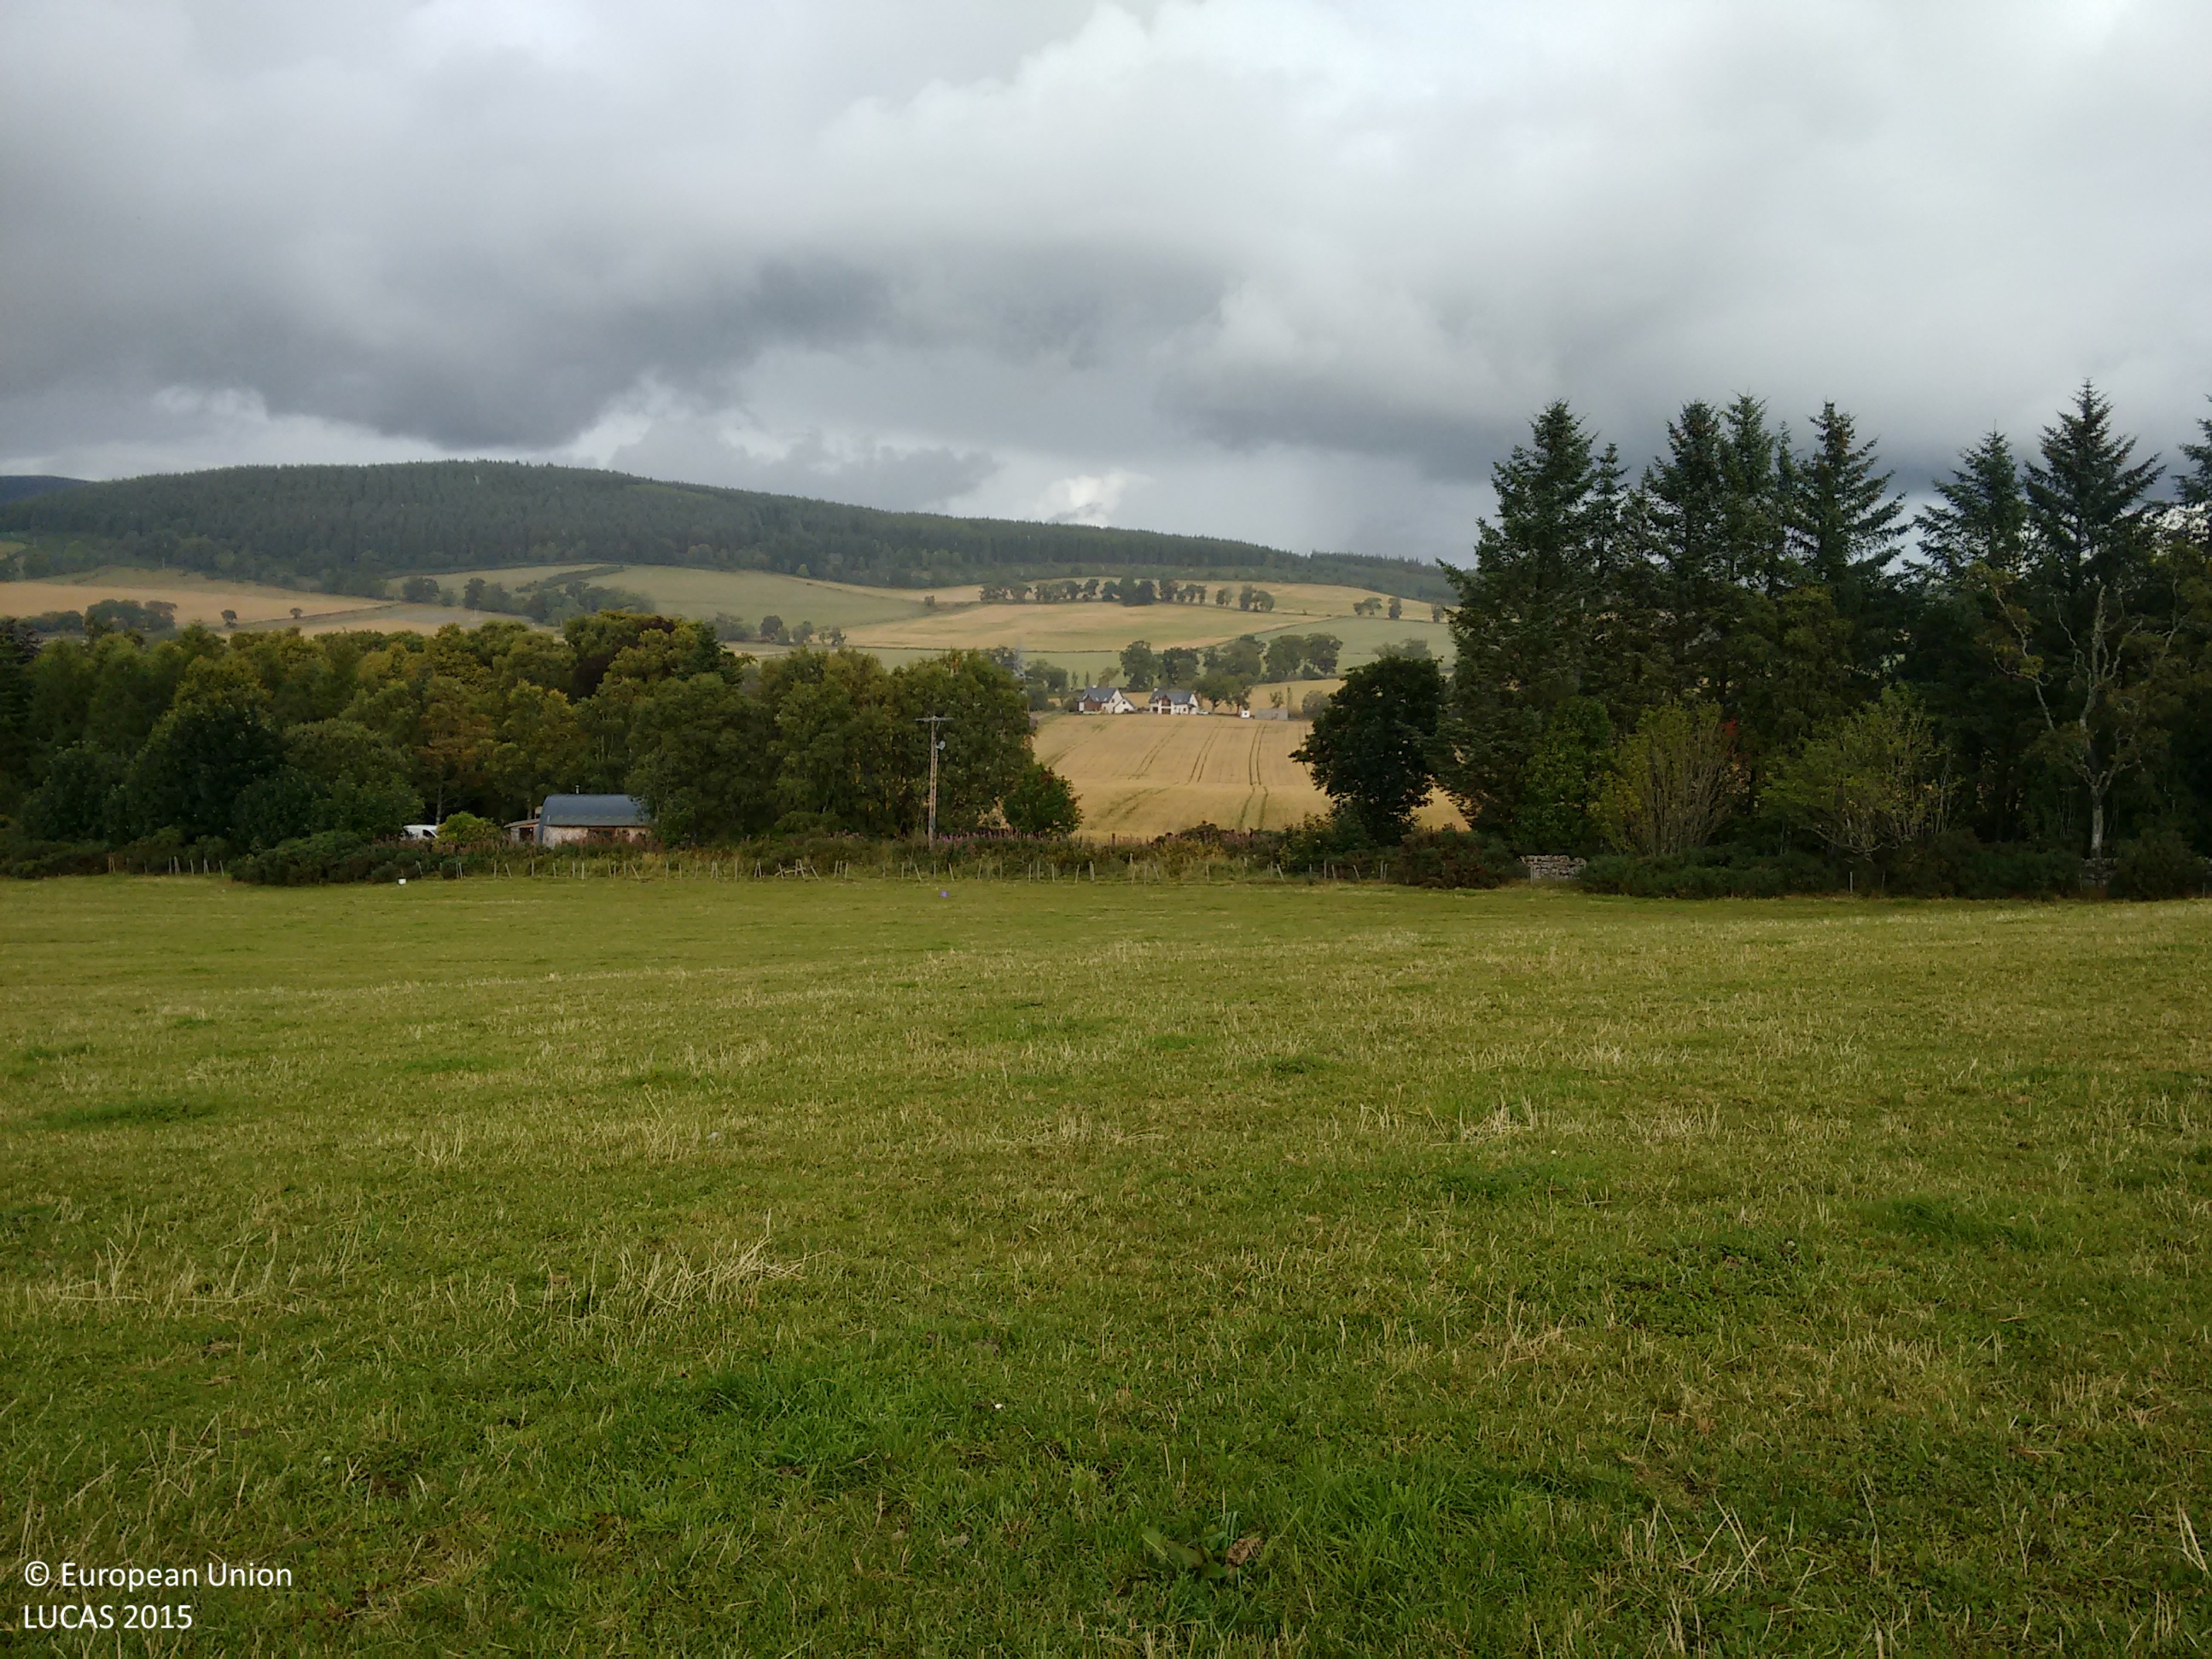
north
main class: Grassland
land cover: Grassland without tree/shrub cover
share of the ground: > 75 %
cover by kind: herbaceous plants 100 %
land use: Agriculture (excluding fallow land and kitchen gardens)
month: September
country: GB
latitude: 57.7267
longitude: -4.2736
